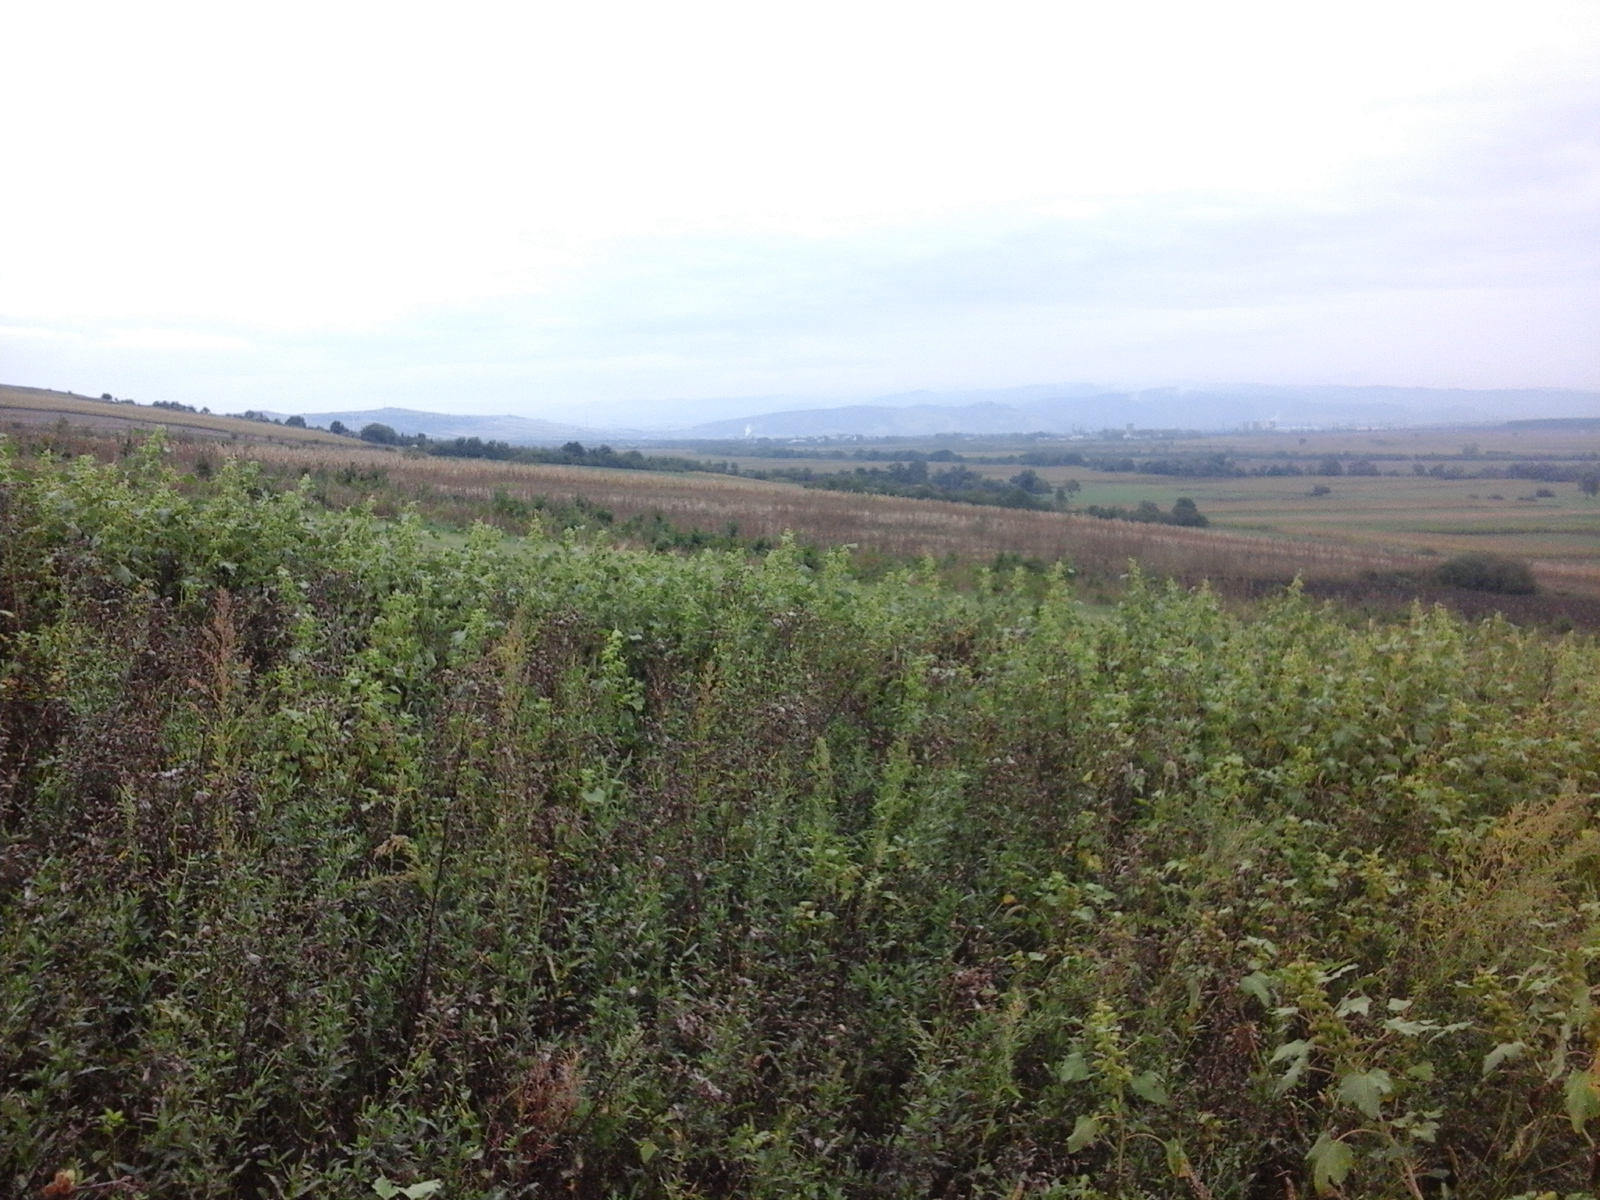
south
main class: Grassland
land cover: Spontaneously vegetated surfaces
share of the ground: > 75 %
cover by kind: herbaceous plants 100 %
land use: Fallow land
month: September
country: RO
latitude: 47.3021
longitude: 22.5551
